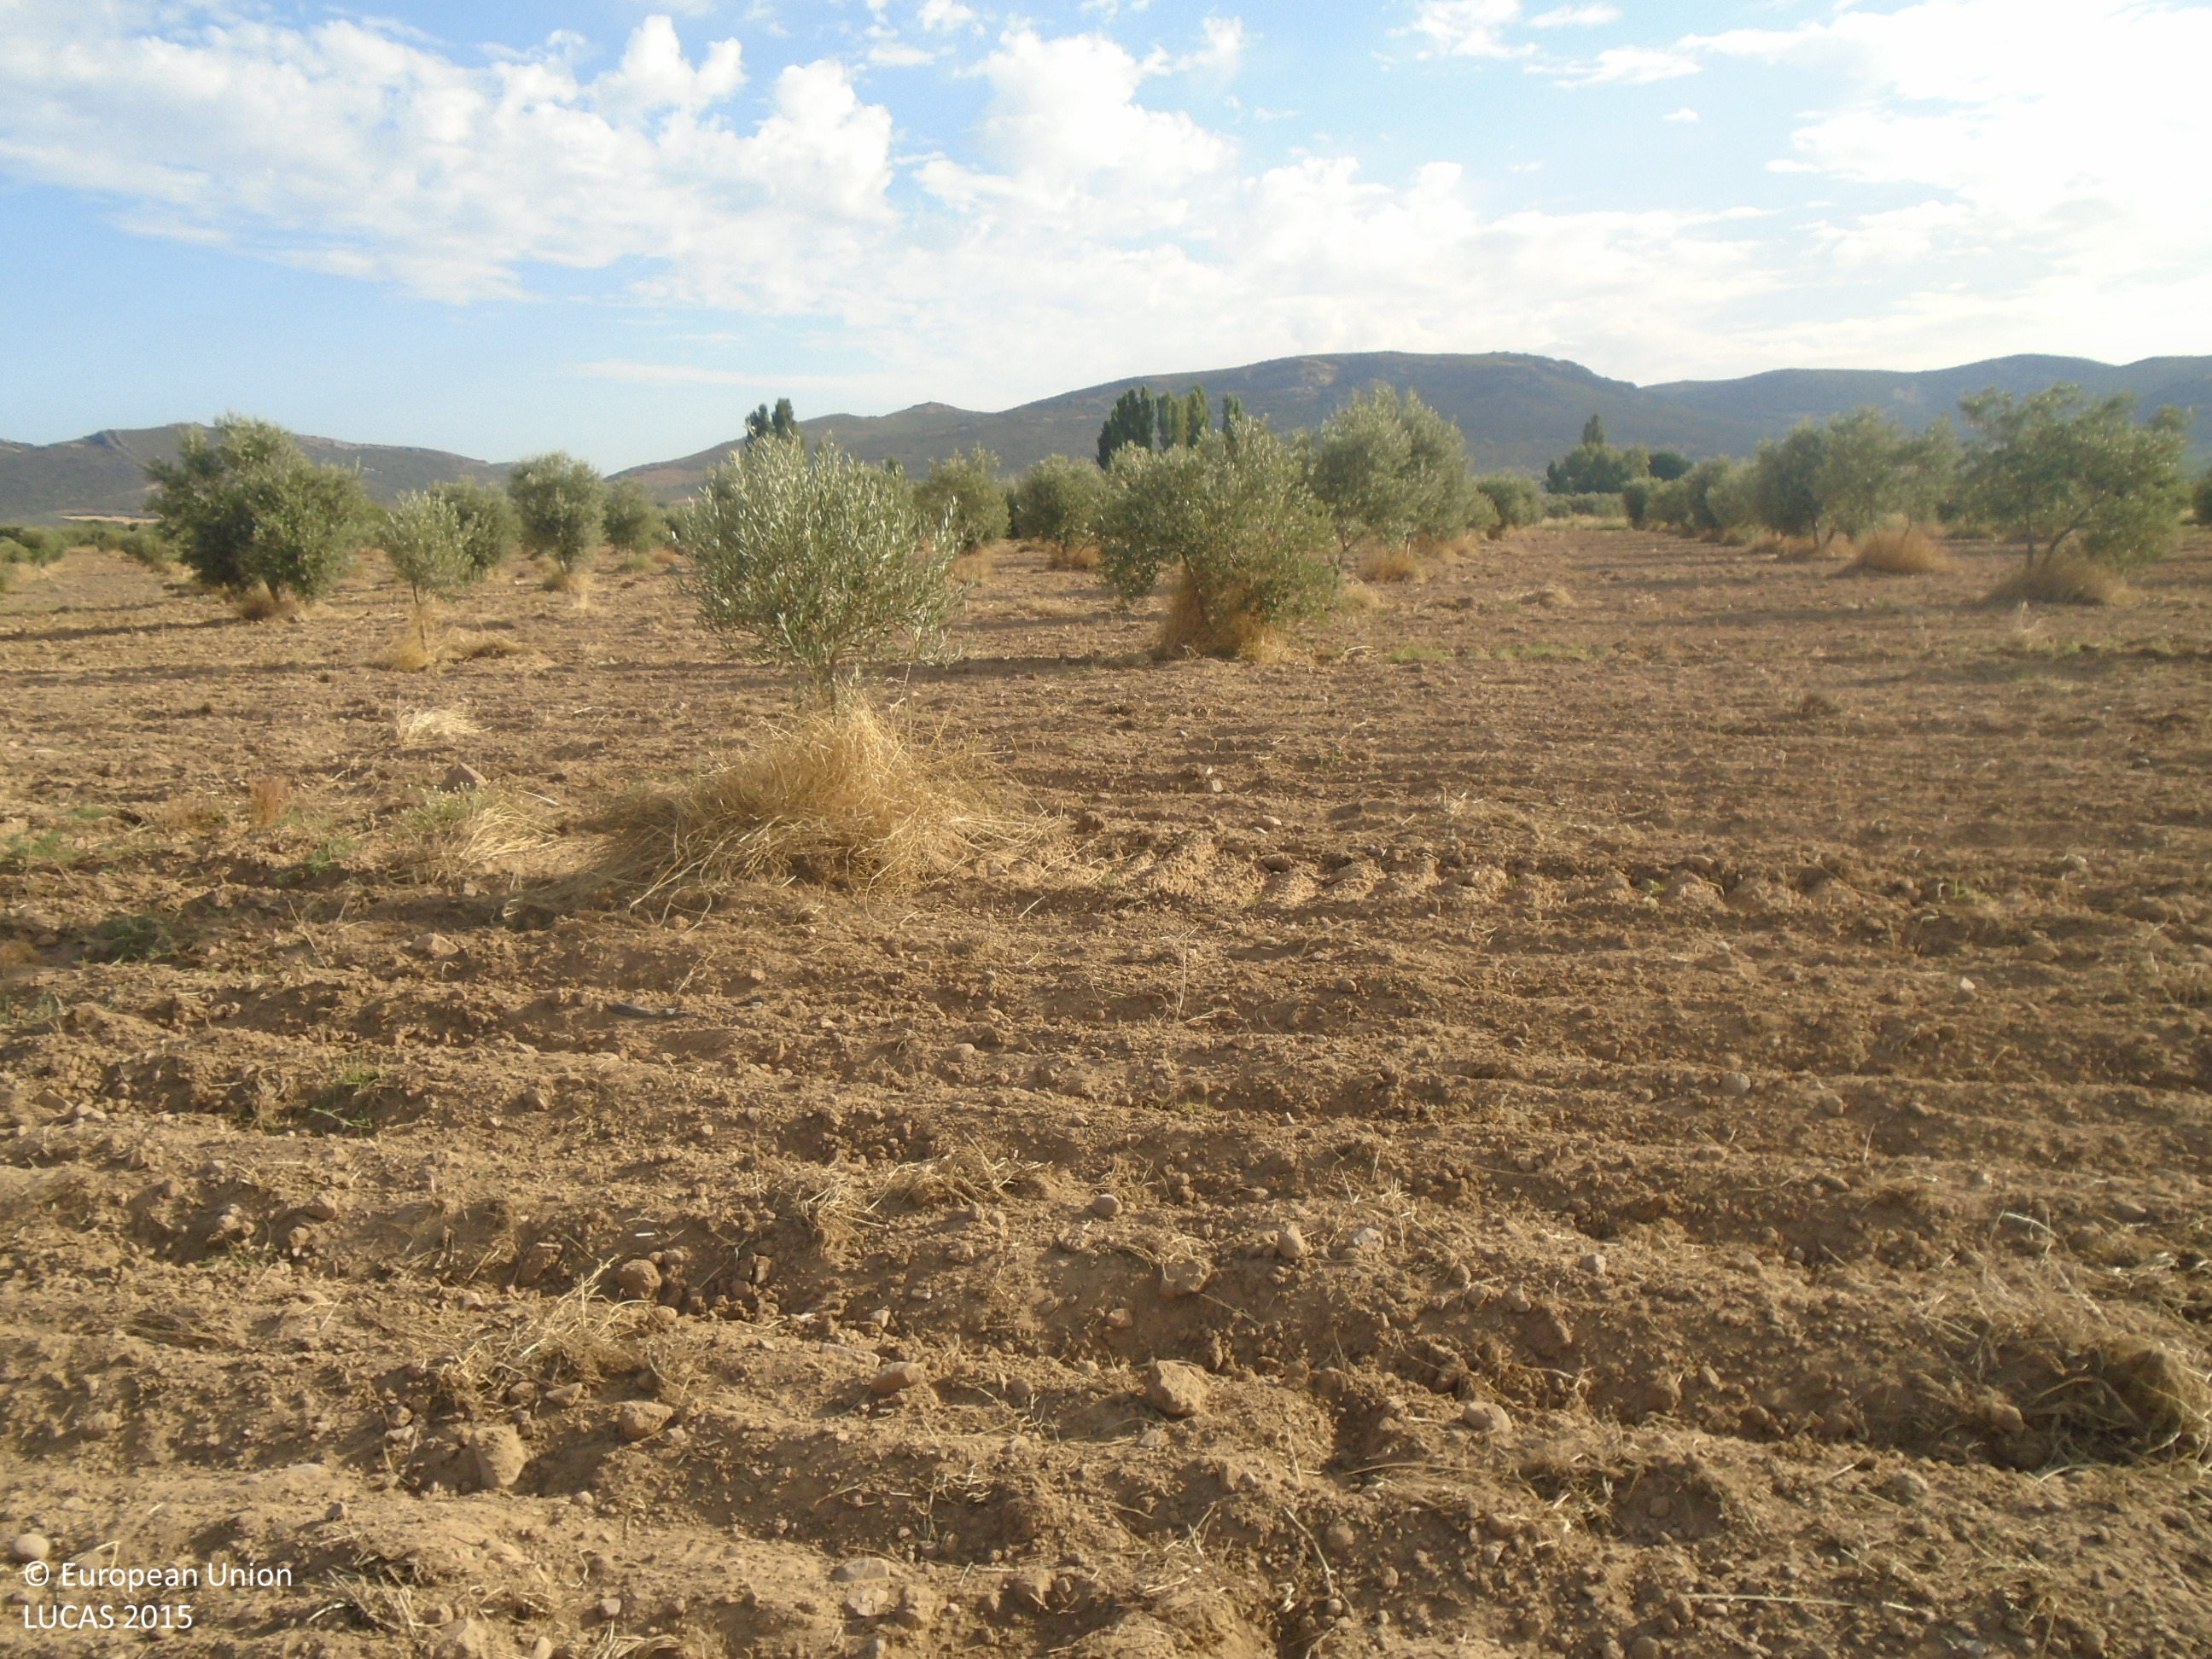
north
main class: Cropland
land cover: Olive groves
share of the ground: < 10 %
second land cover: Other bare soil
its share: > 75 %
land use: Agriculture (excluding fallow land and kitchen gardens)
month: July
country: ES
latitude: 39.1784
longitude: -4.0431
